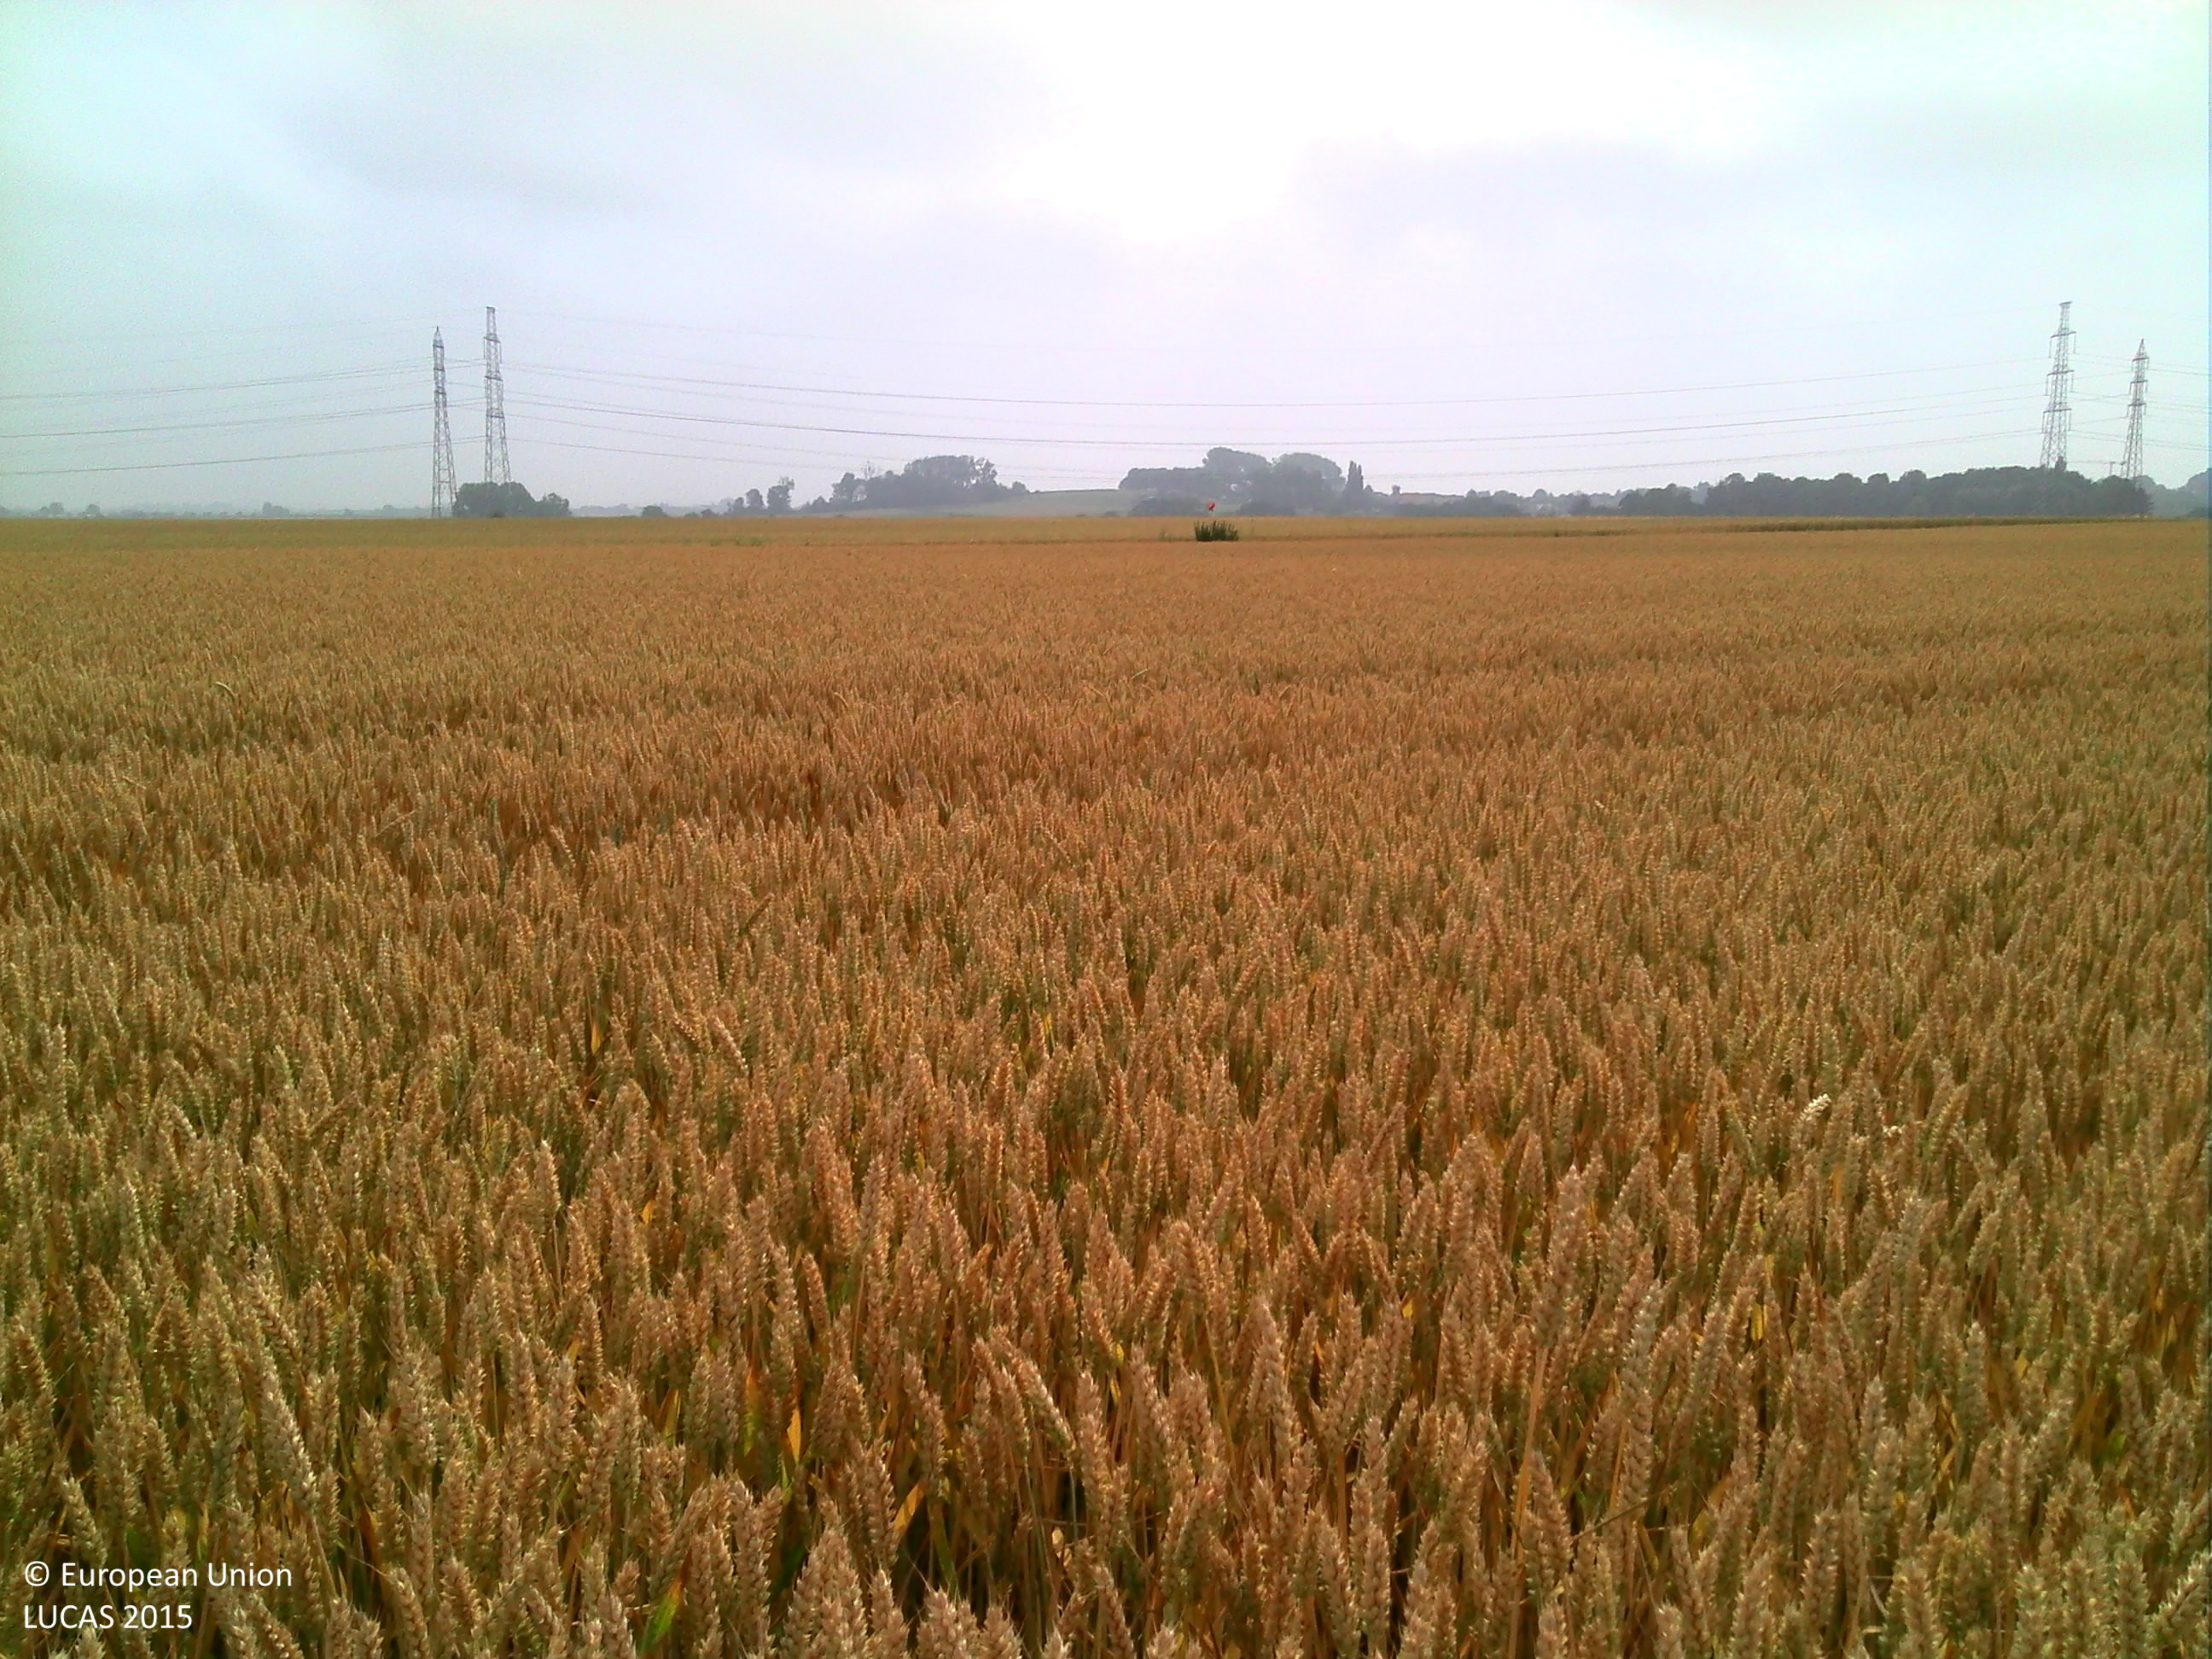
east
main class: Cropland
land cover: Common wheat
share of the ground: > 75 %
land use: Agriculture (excluding fallow land and kitchen gardens)
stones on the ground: < 10 %
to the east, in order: Common wheat; Grass margins; Paved roads, cycling and walking lanes; Grass margins; Common wheat
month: July
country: BE
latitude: 50.8180
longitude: 5.5555
